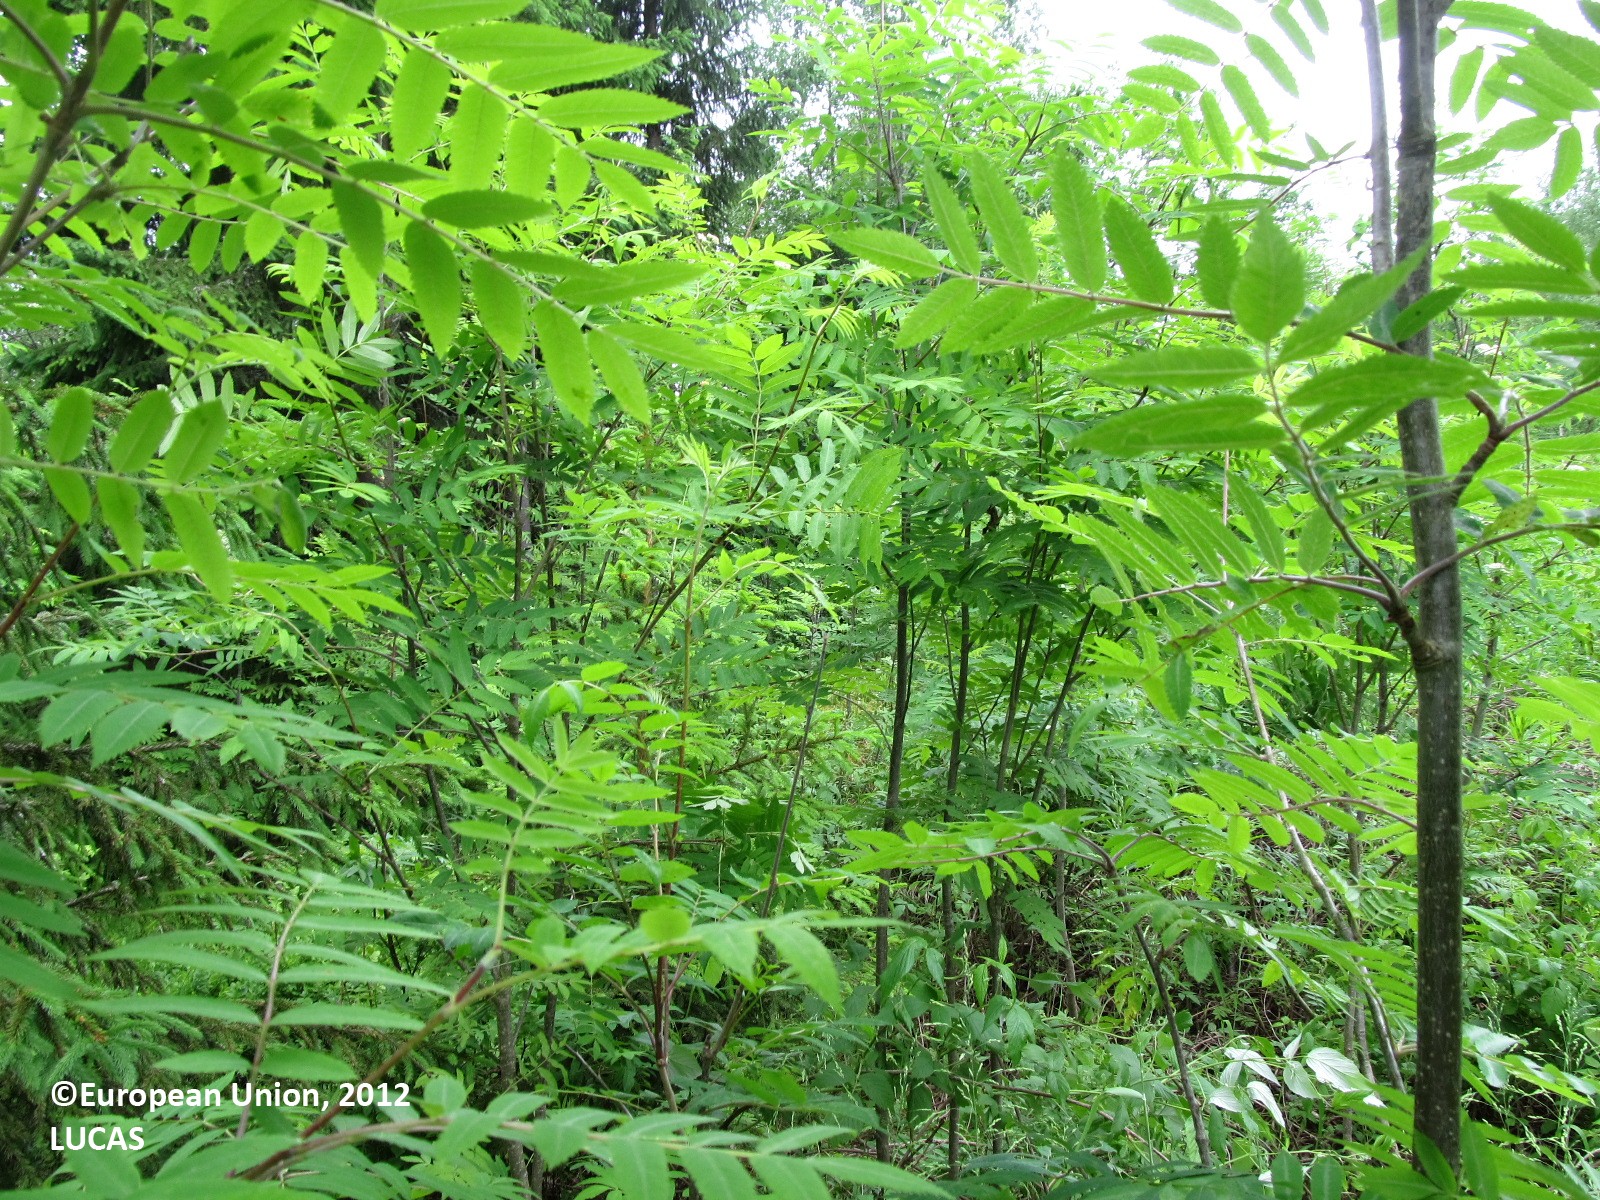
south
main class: Woodland
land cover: Broadleaved woodland
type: boreal forest
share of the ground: 50 - 75 %
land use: Forestry
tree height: < 5 m
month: June
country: FI
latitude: 63.1886
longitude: 27.6721
